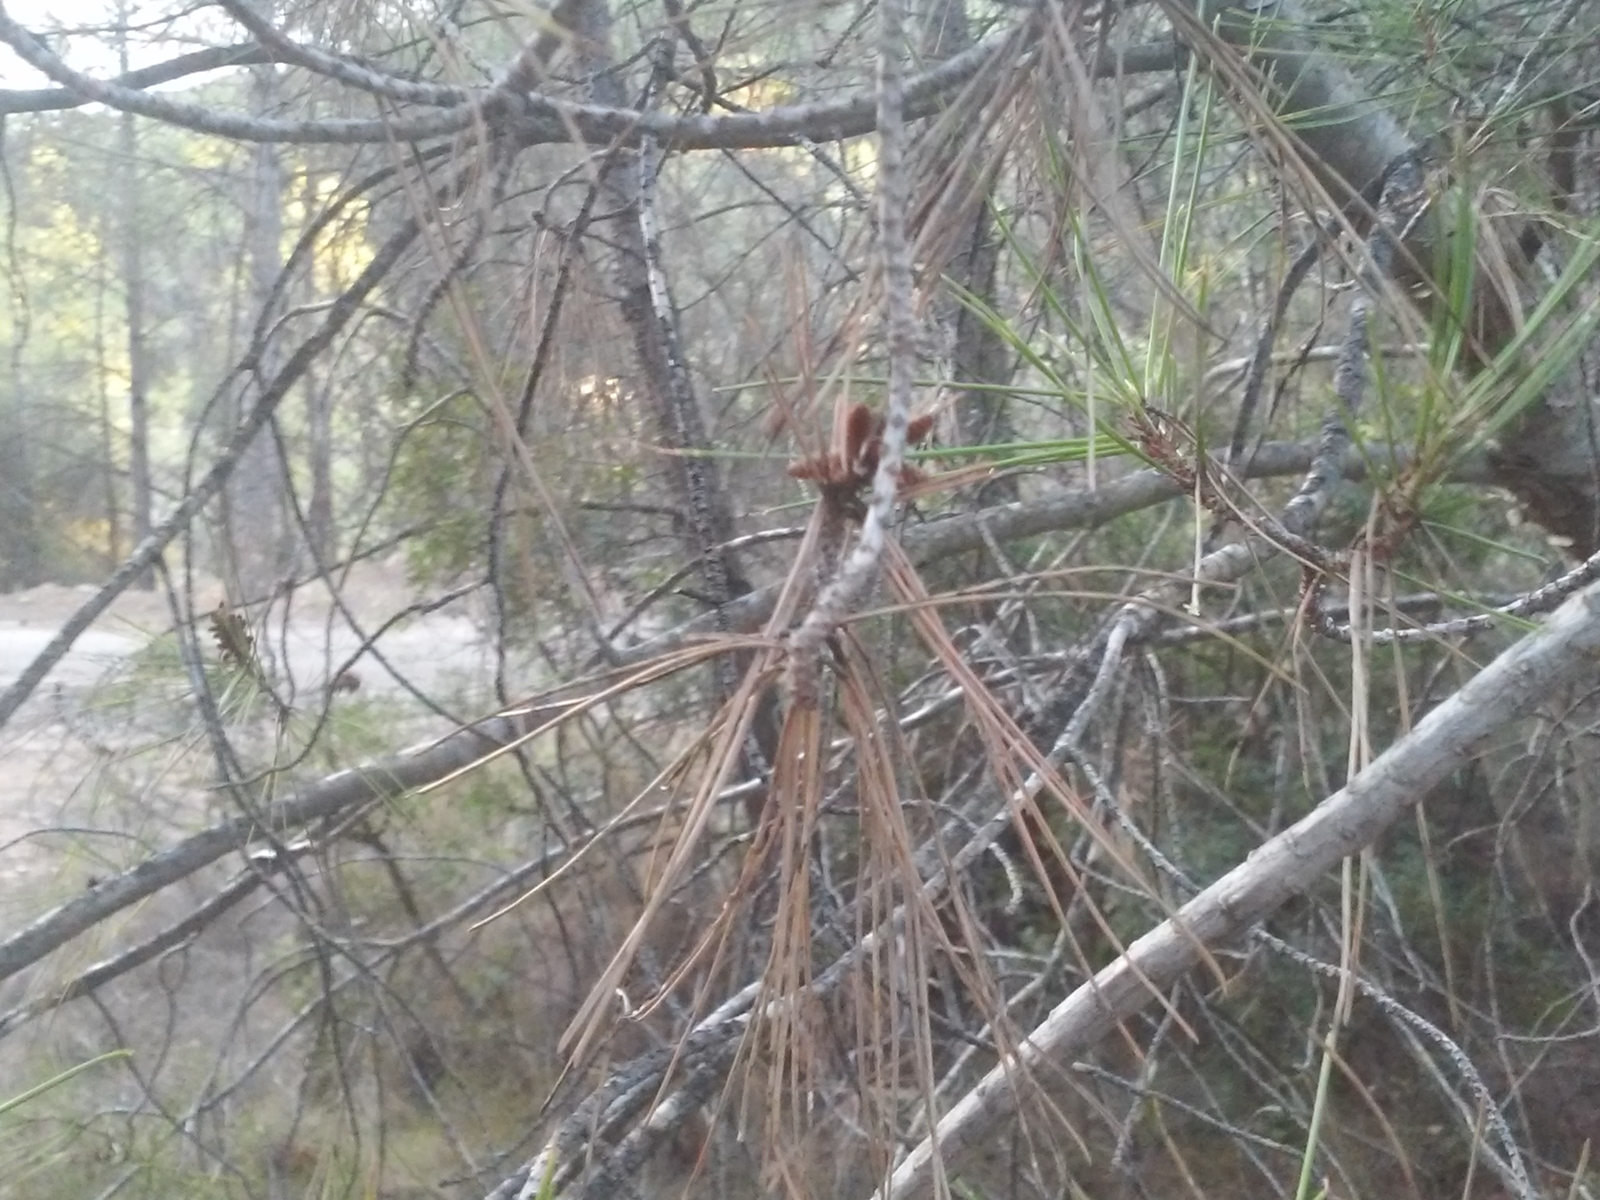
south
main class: Woodland
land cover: Pine dominated coniferous woodland
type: coniferous forest of the mediterranean region
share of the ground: 50 - 75 %
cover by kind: coniferous forest trees 50 %, shrubs 35 %, herbaceous plants 10 %, broadleaved forest trees 5 %
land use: Semi-natural and natural areas not in use
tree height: < 5 m
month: September
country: ES
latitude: 41.1672
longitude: 0.6591
